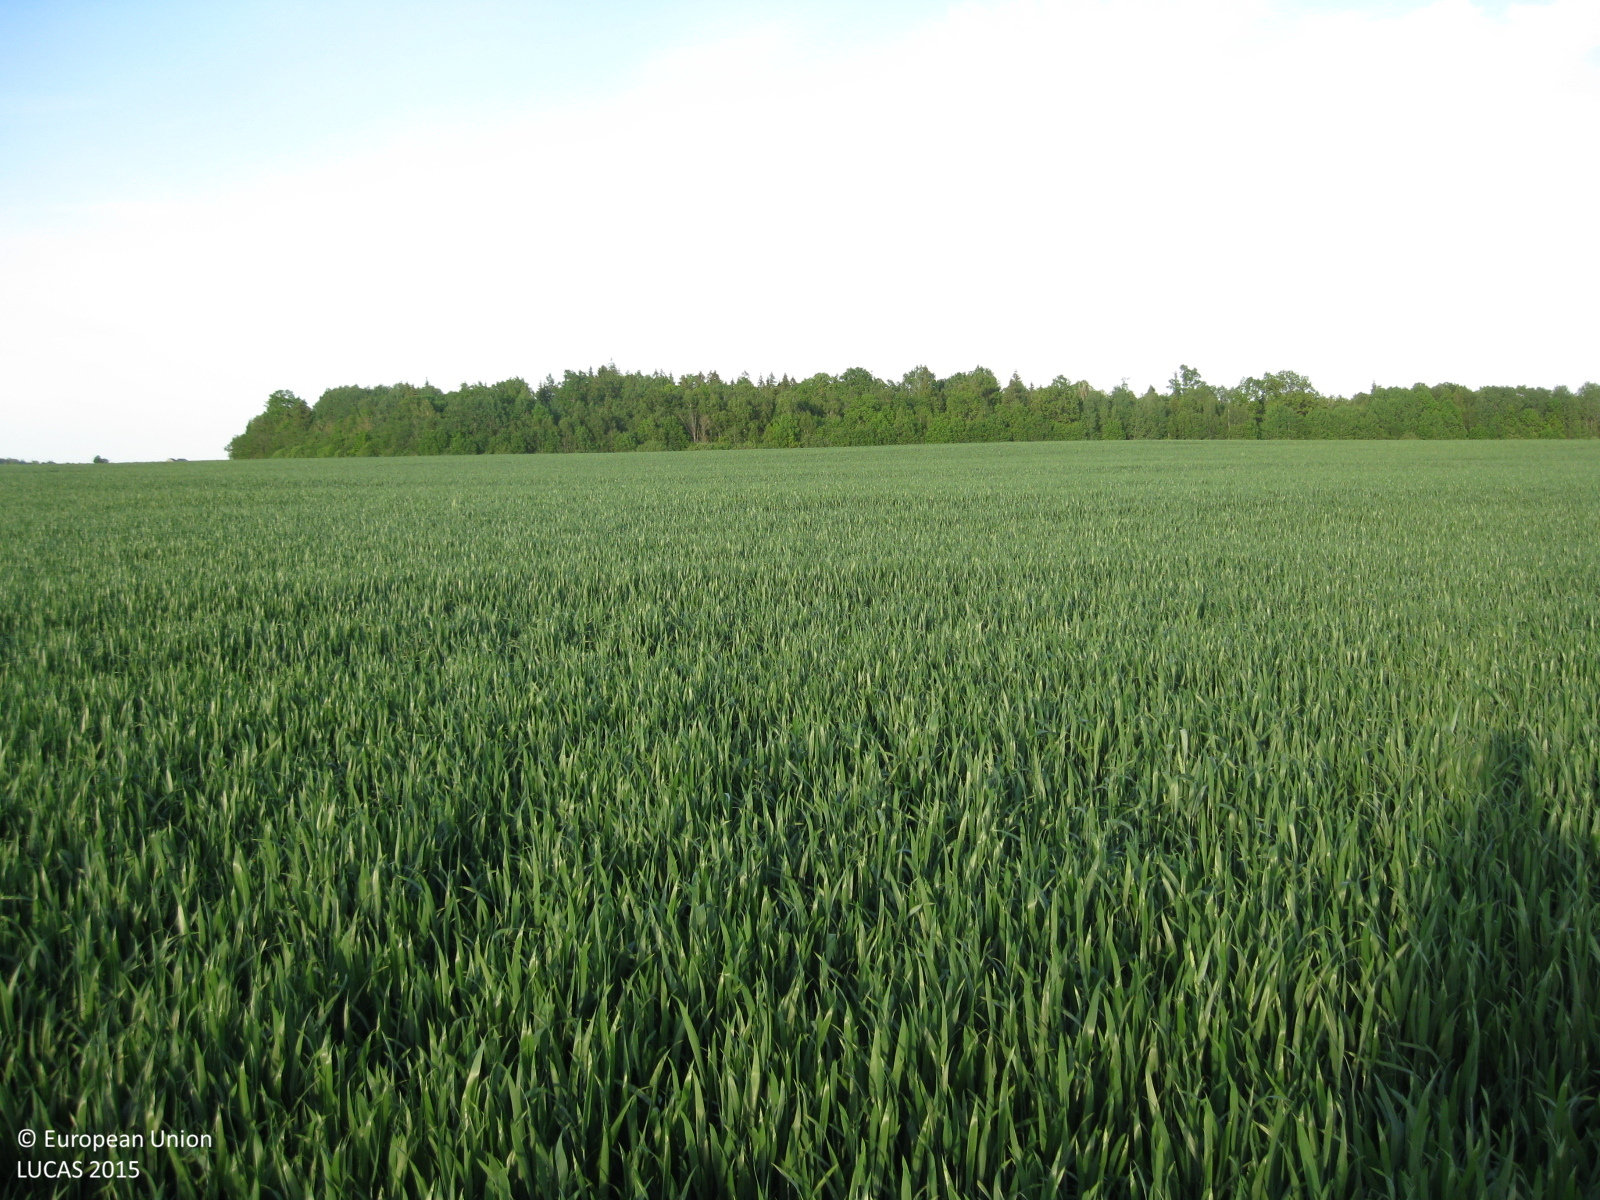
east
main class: Cropland
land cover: Common wheat
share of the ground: > 75 %
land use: Agriculture (excluding fallow land and kitchen gardens)
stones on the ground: < 10 %
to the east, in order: Common wheat
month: June
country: LT
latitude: 55.4798
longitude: 23.5773
